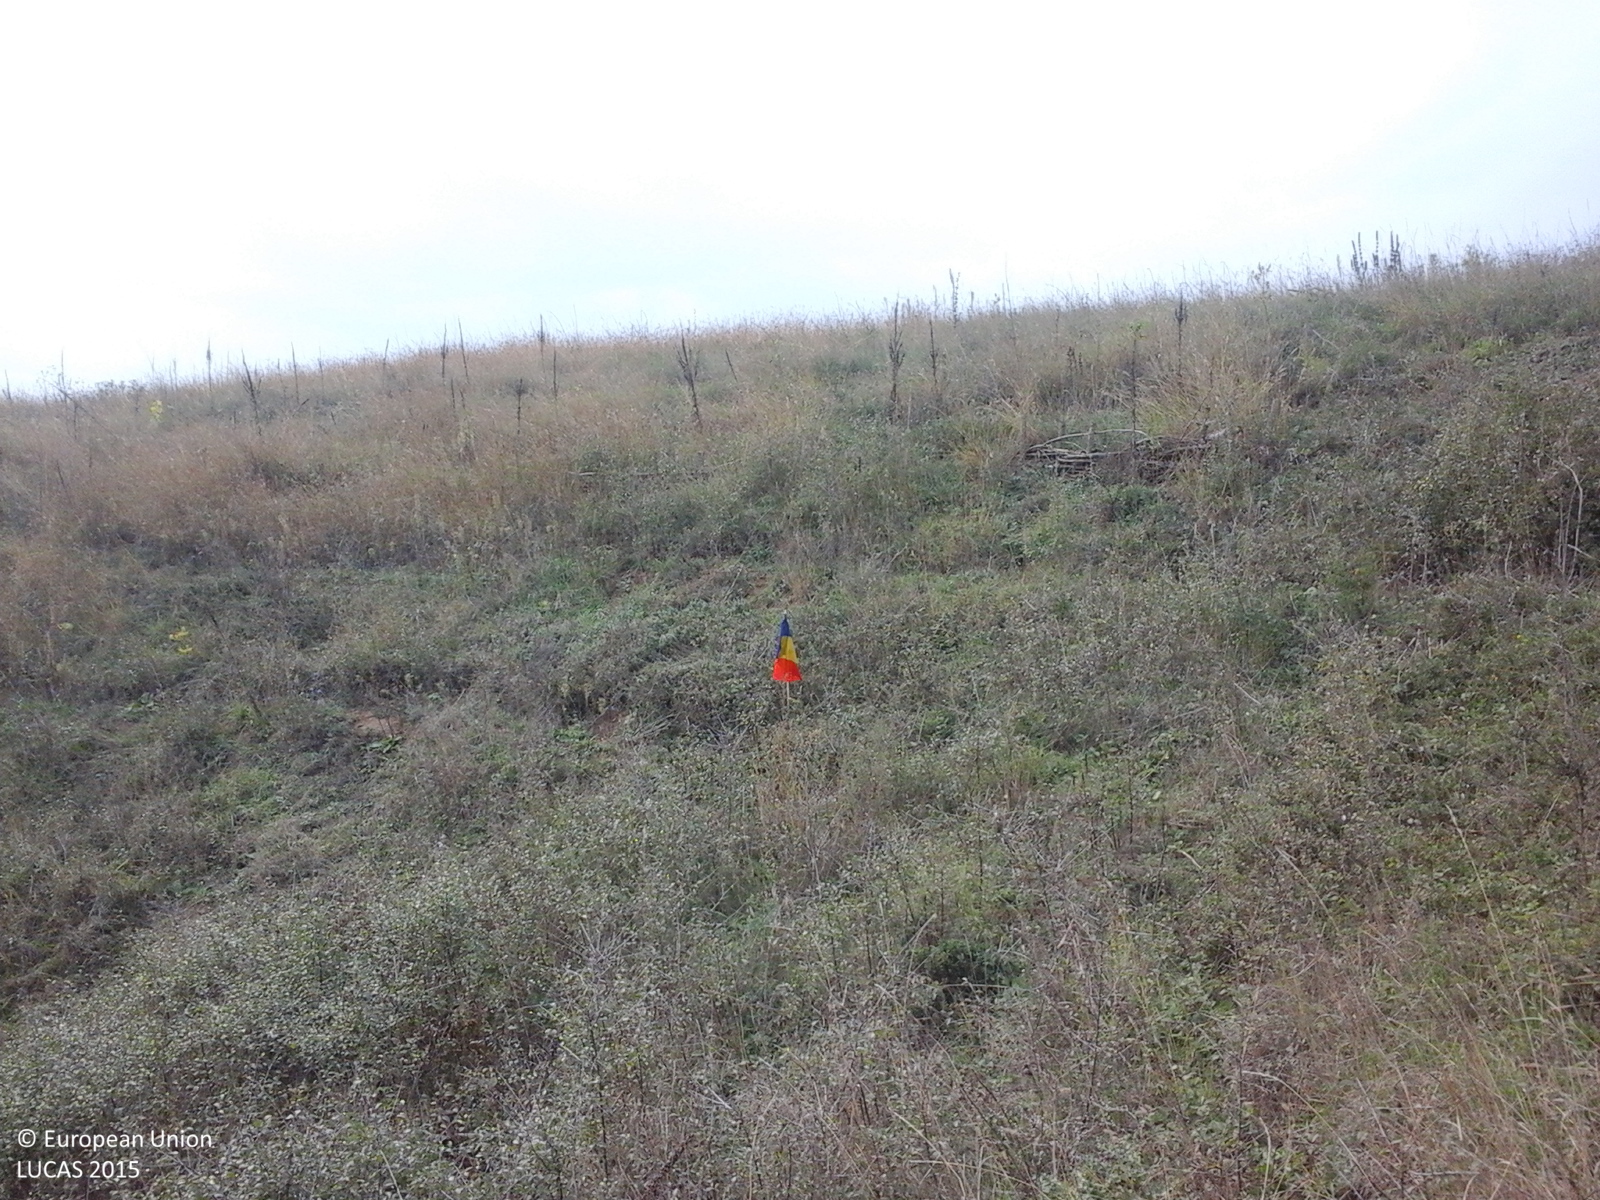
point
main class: Grassland
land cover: Grassland with sparse tree/shrub cover
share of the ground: > 75 %
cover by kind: herbaceous plants 95 %, broadleaved forest trees 5 %
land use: Agriculture (excluding fallow land and kitchen gardens)
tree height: < 5 m
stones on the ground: < 10 %
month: October
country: RO
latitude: 46.4380
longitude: 23.9368
